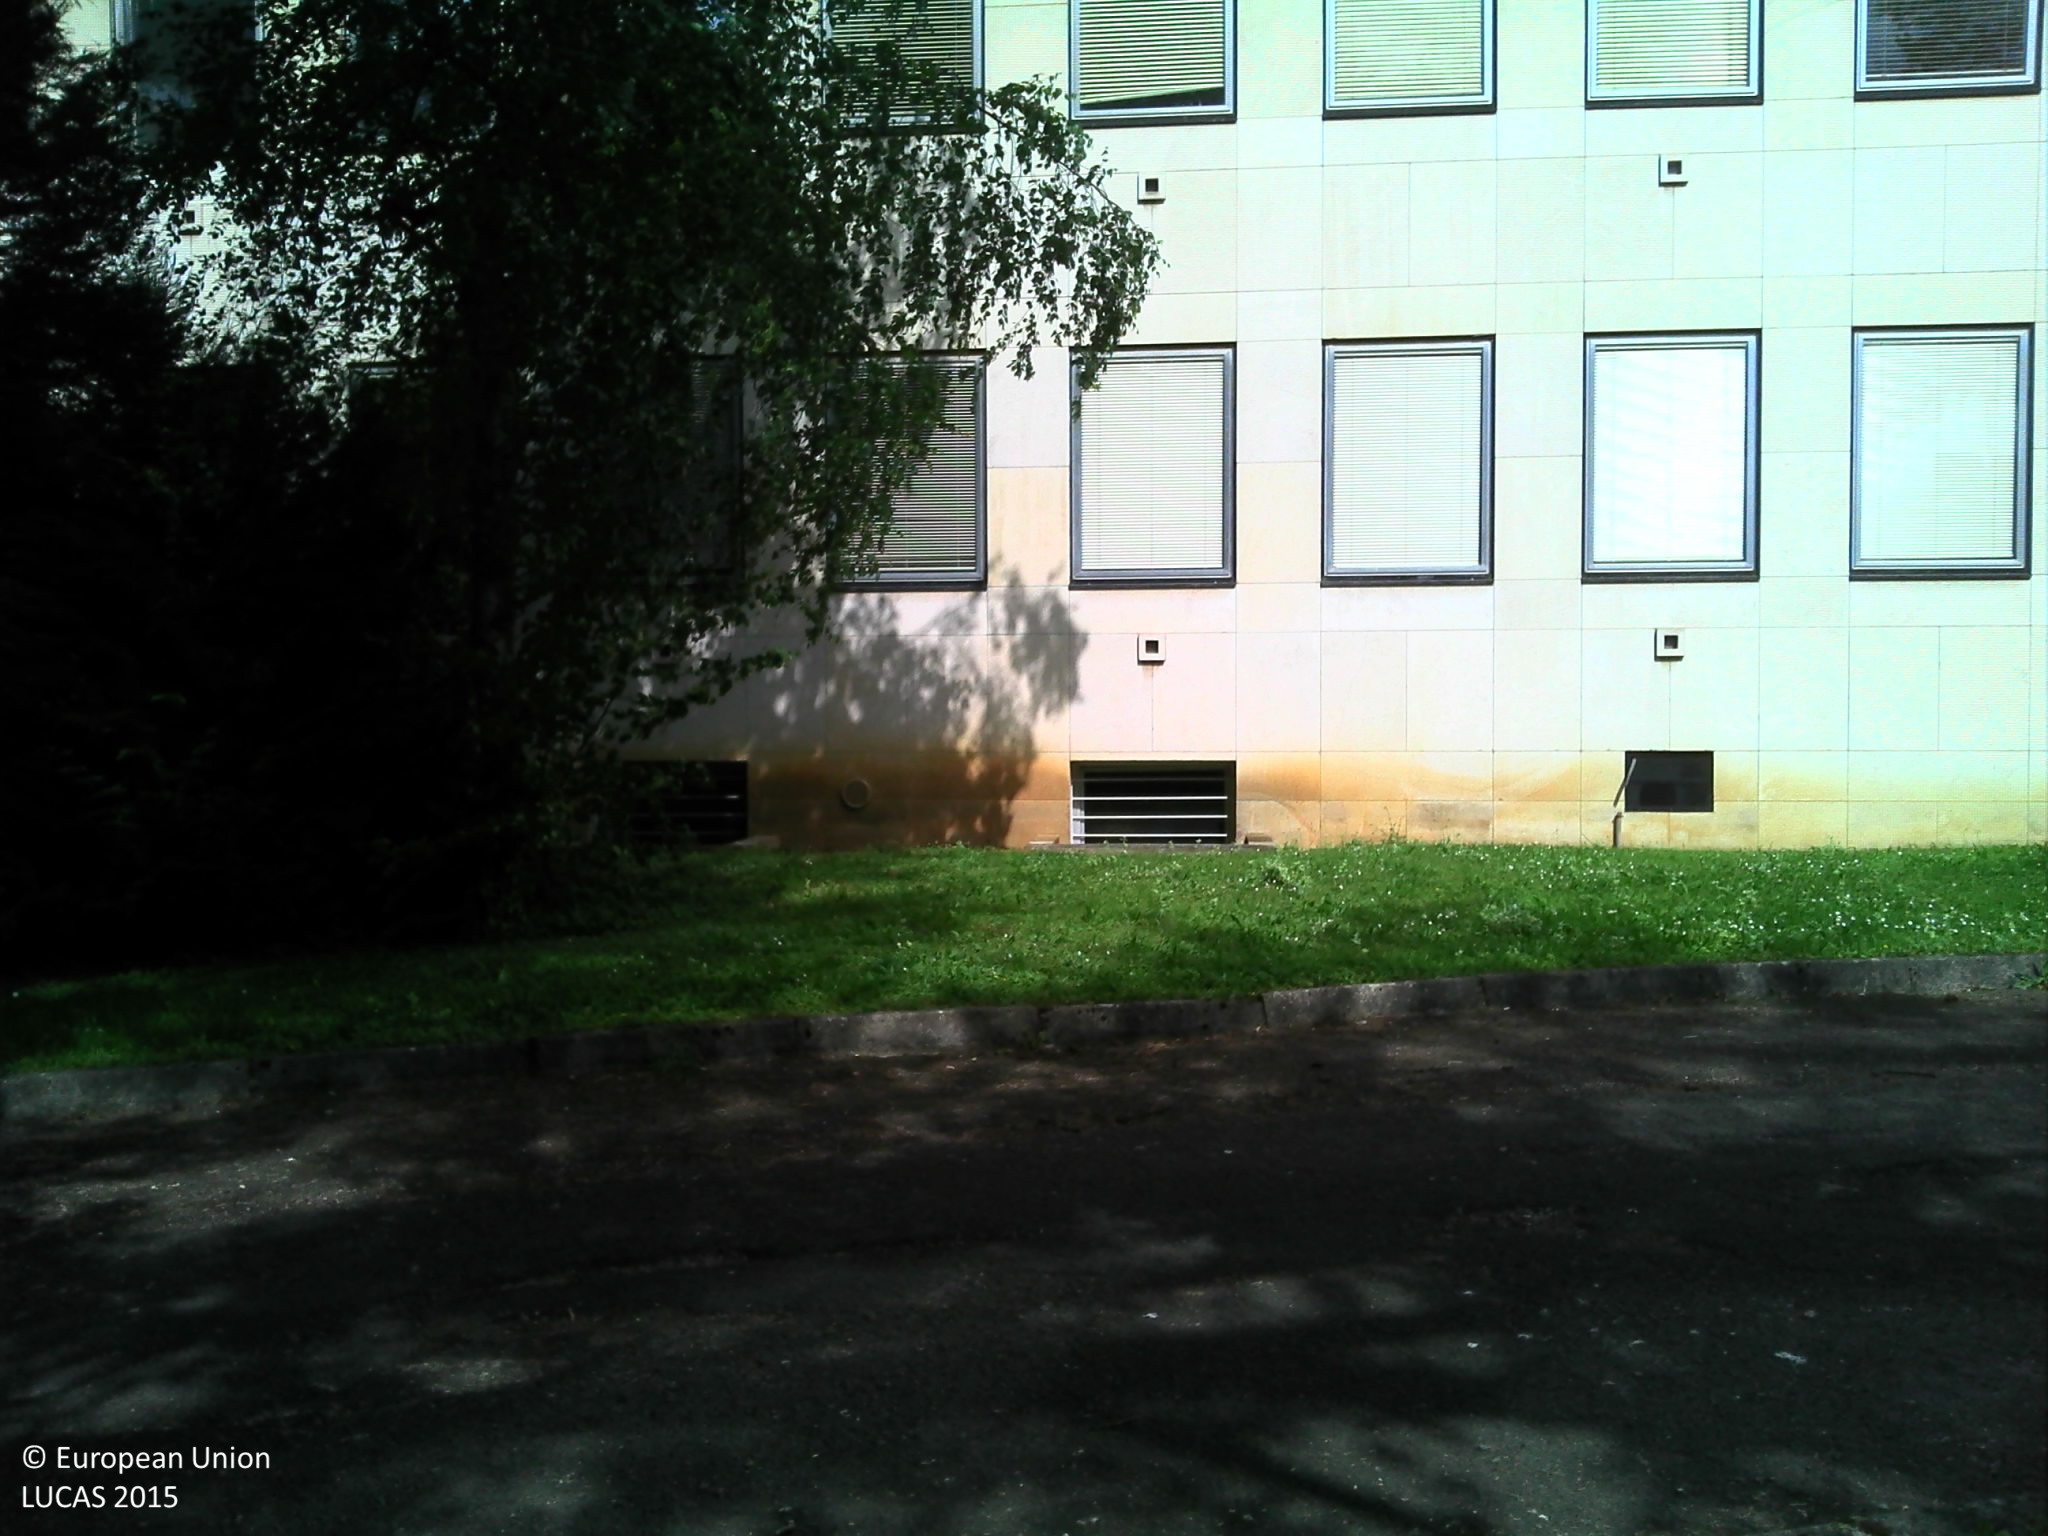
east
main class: Woodland
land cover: Pine dominated mixed woodland
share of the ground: > 75 %
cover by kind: herbaceous plants 65 %, coniferous forest trees 20 %, broadleaved forest trees 15 %
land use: Community services
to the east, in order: Pine dominated mixed woodland; Artificial constructions in urban areas
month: June
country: FR
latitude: 47.3197
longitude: 5.0657
